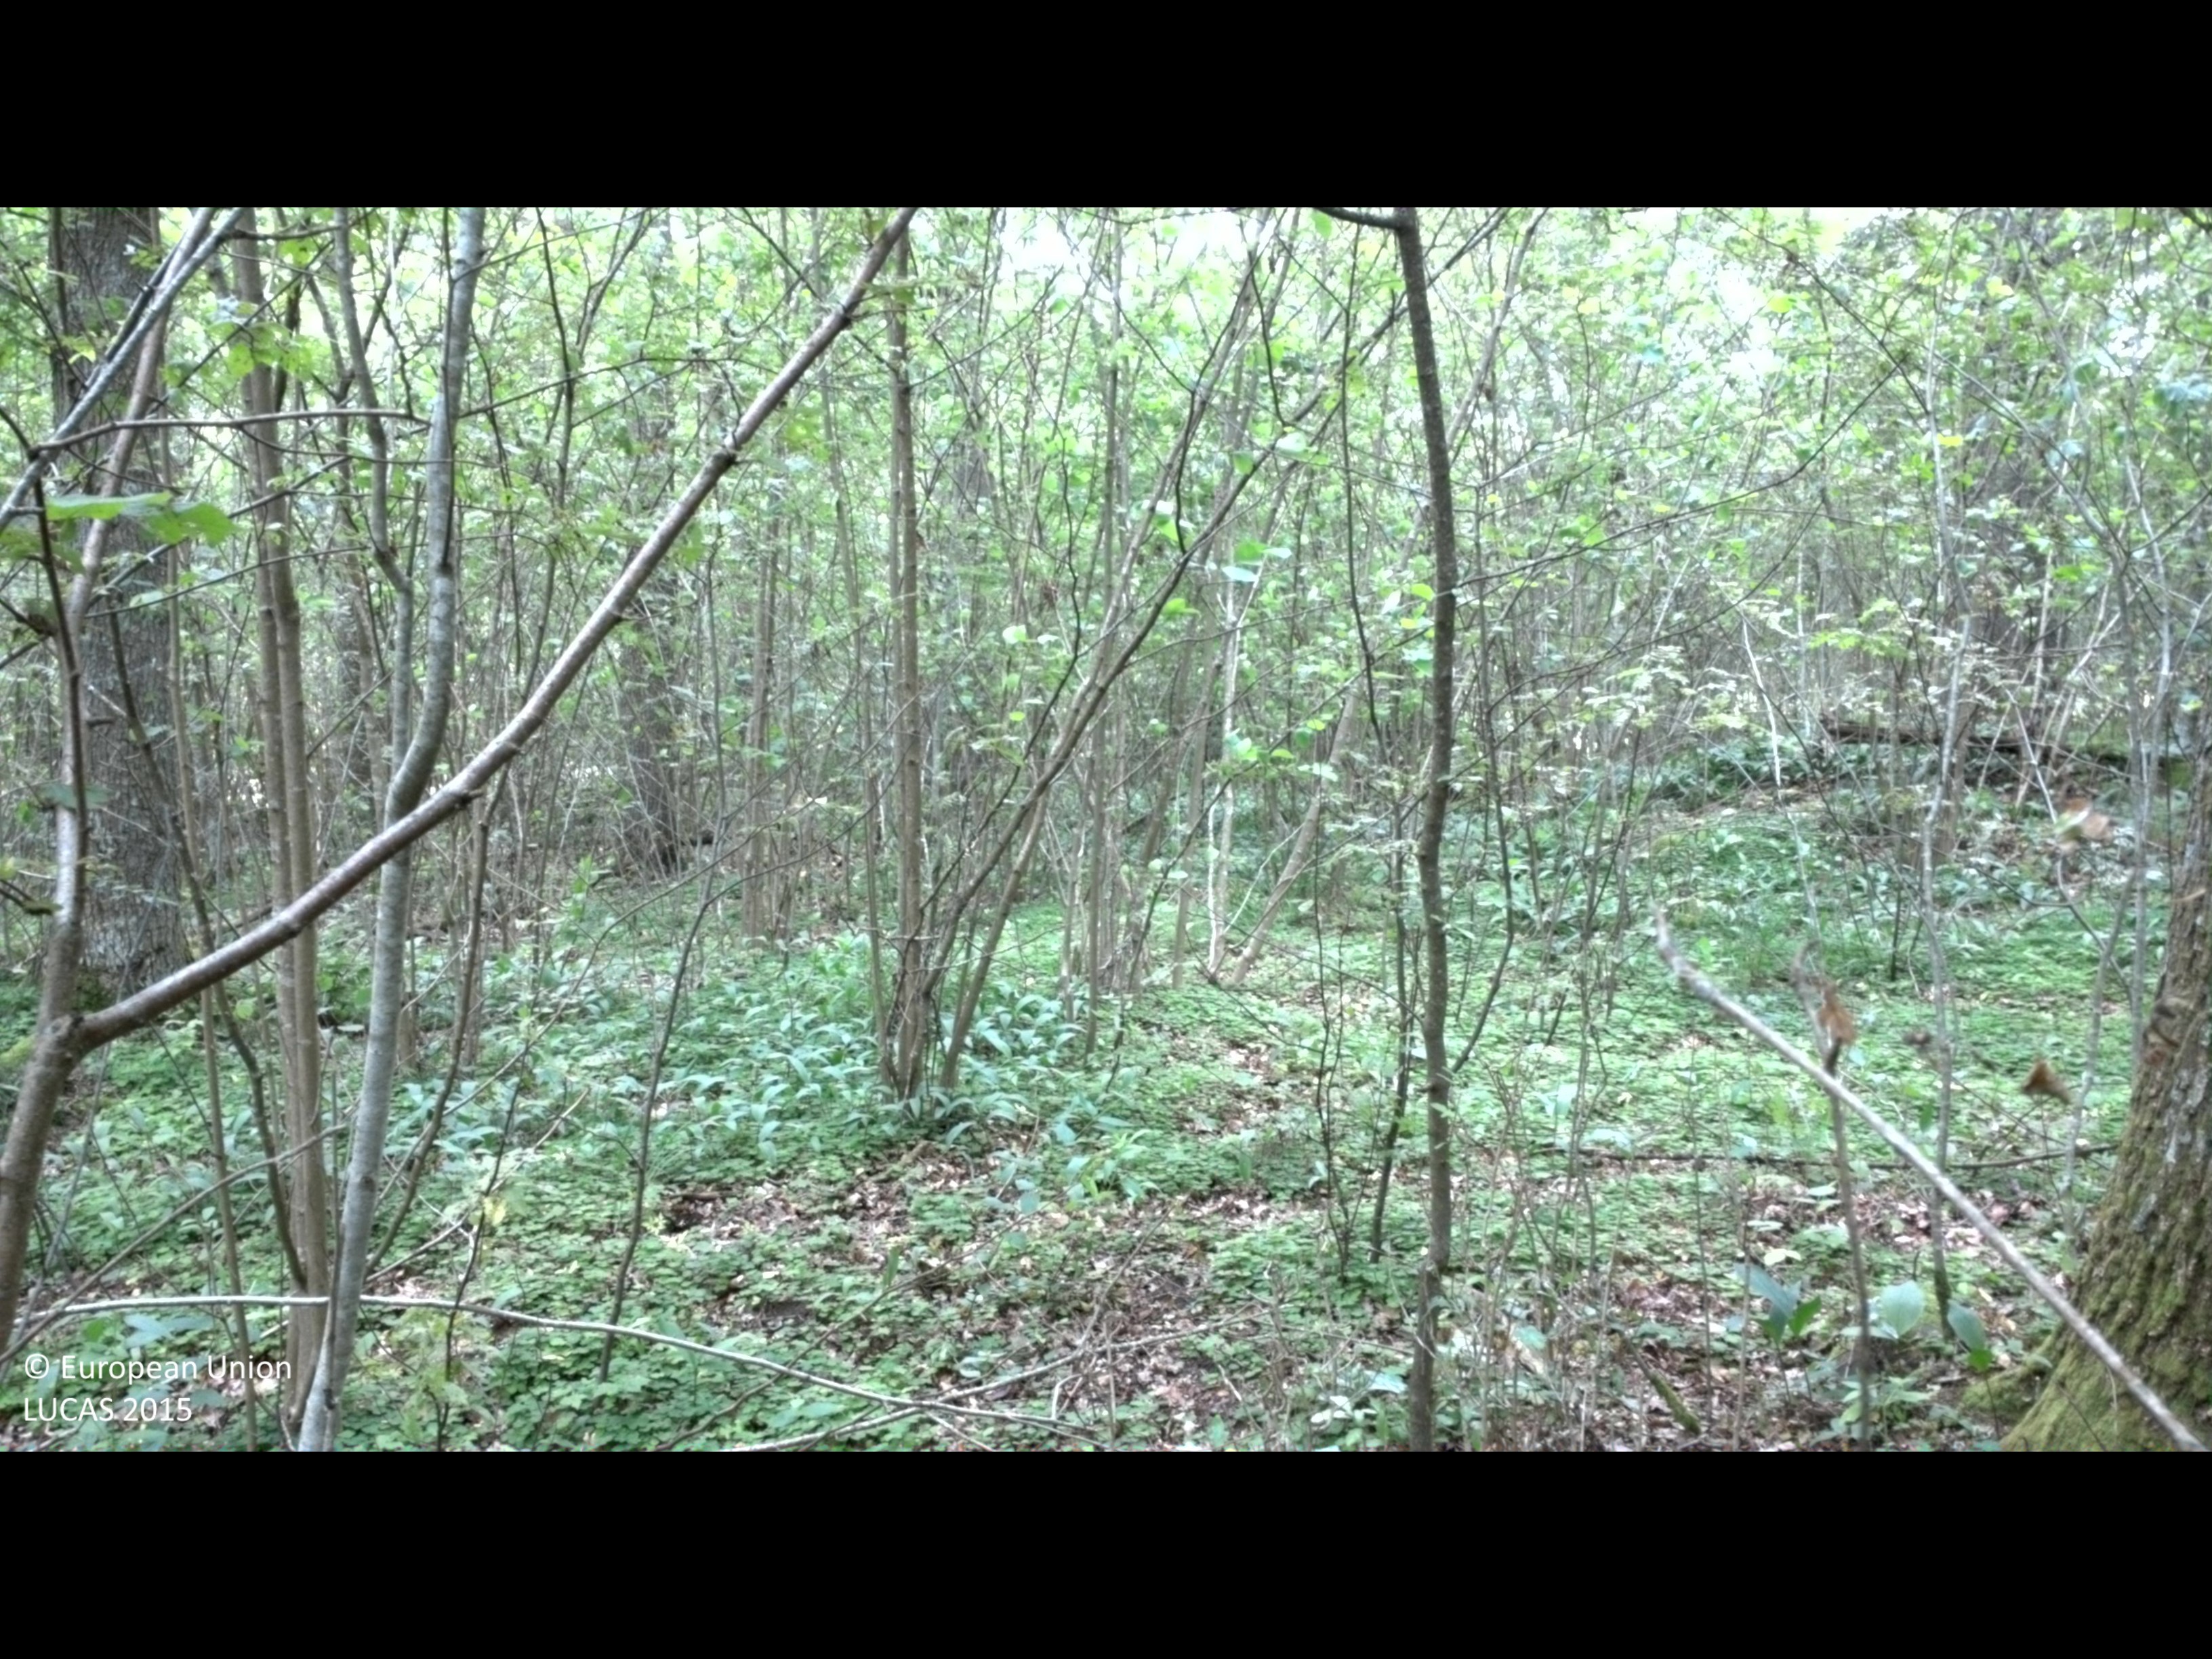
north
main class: Woodland
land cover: Broadleaved woodland
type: boreal forest
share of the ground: > 75 %
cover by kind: broadleaved forest trees 75 %, shrubs 20 %, herbaceous plants 5 %
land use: Forestry
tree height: > 5 m
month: July
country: SE
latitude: 56.8161
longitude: 13.7808
